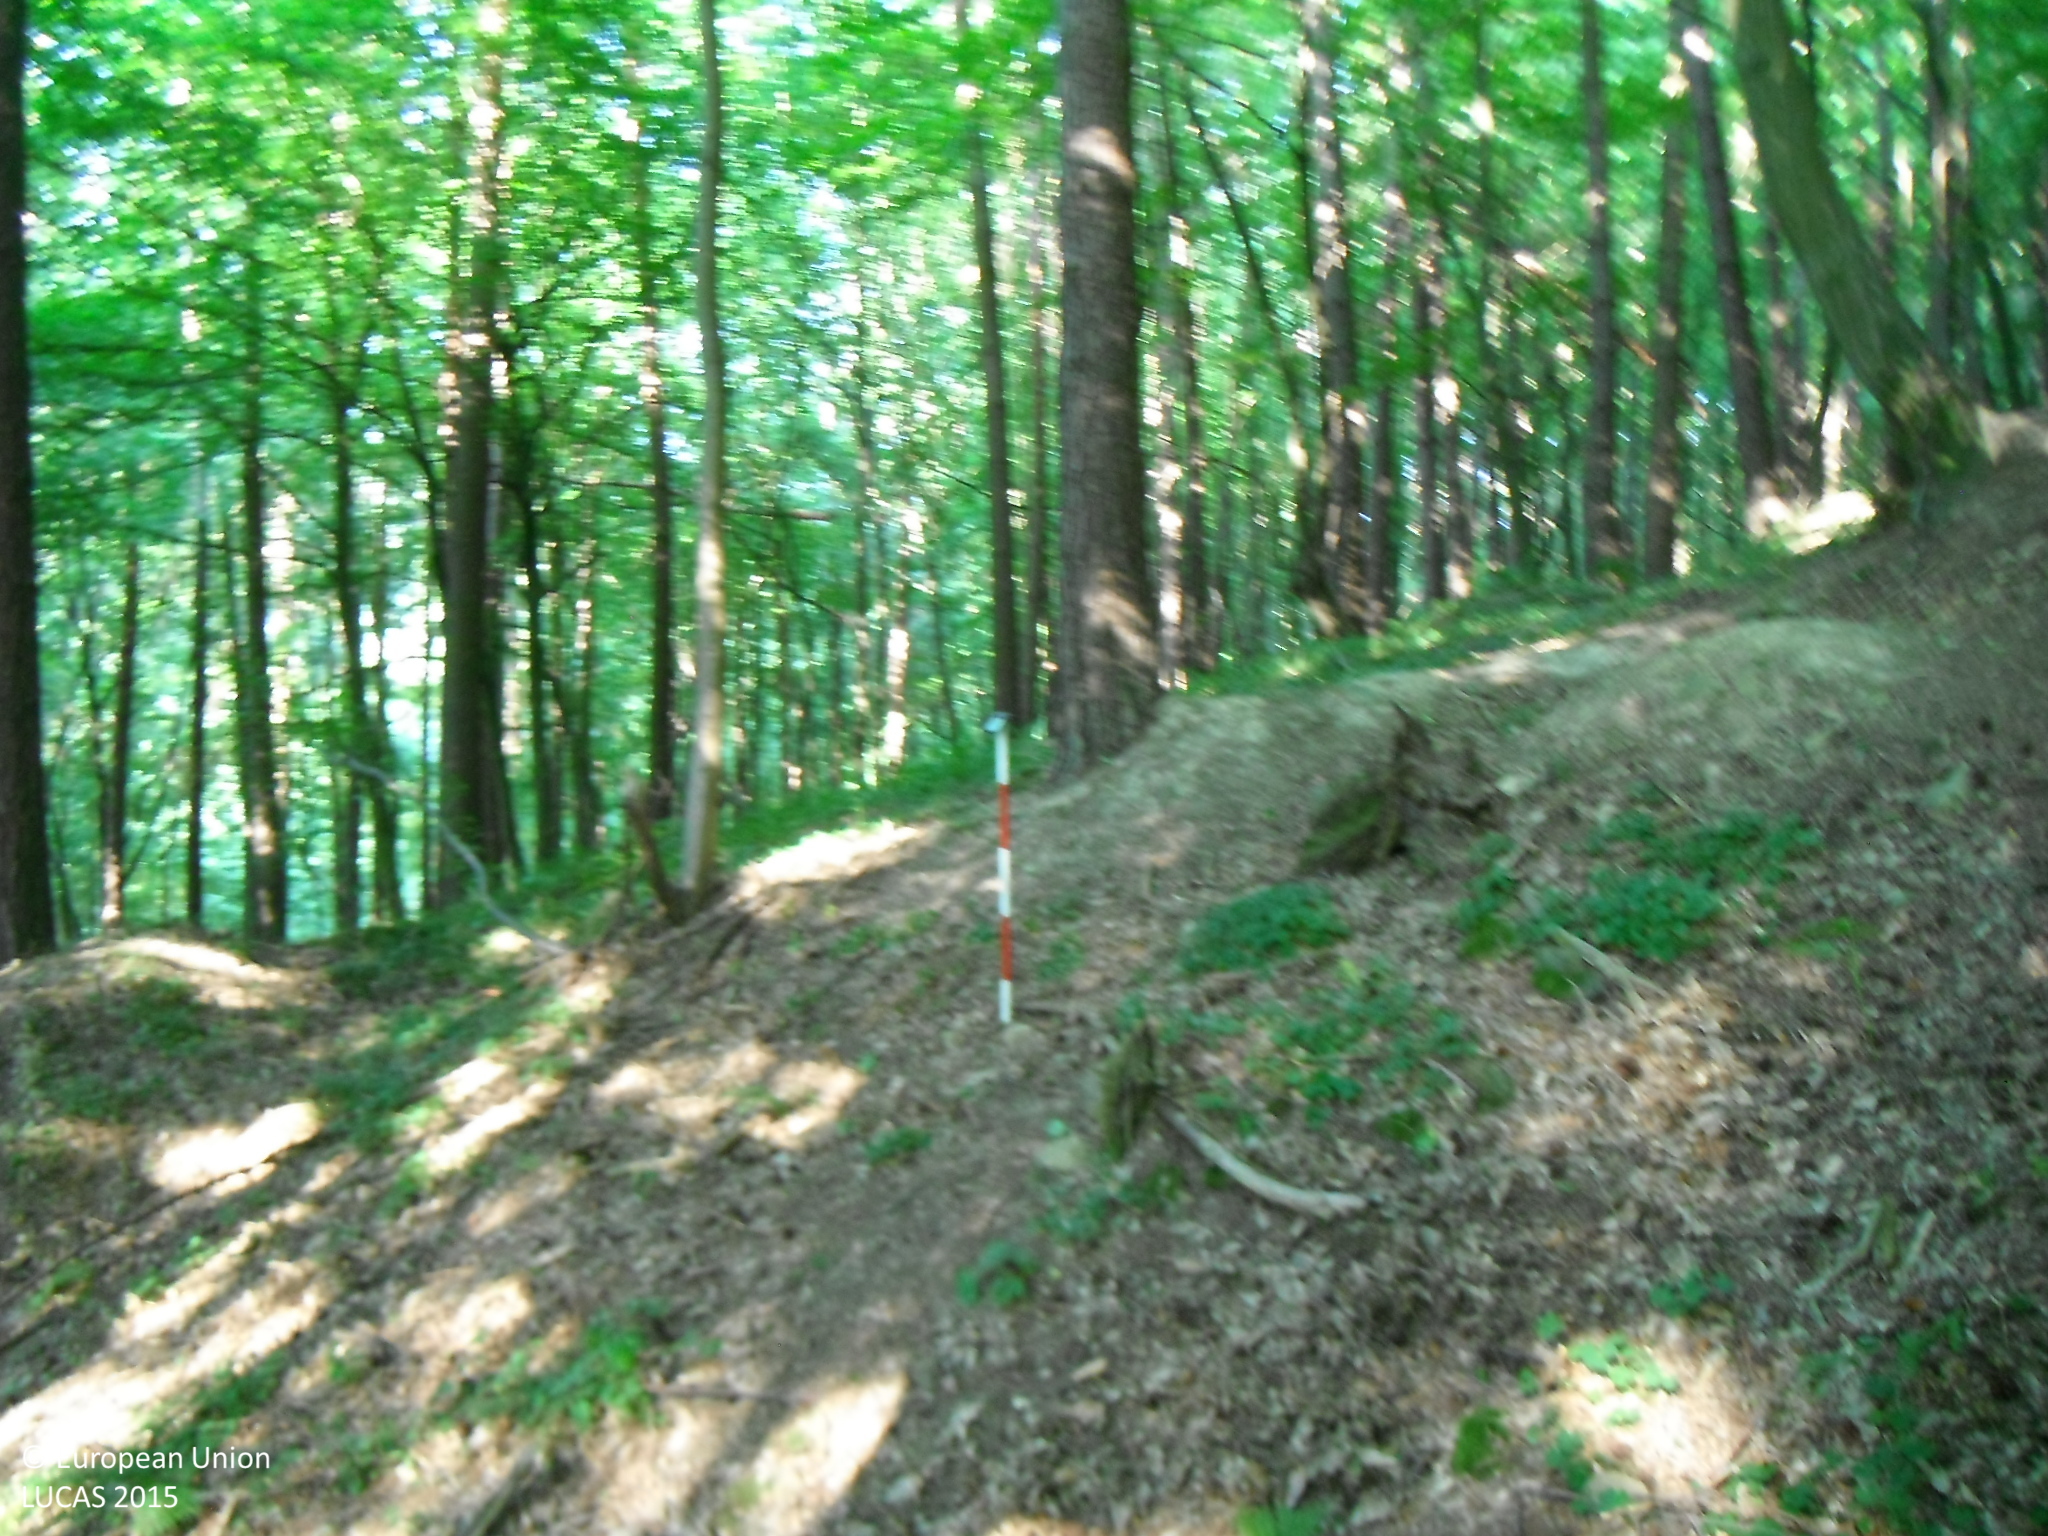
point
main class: Woodland
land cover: Pine dominated mixed woodland
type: hemiboreal forest and nemoral coniferous forest and mixed broadleaved-coniferous forest
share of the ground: > 75 %
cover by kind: coniferous forest trees 50 %, broadleaved forest trees 50 %
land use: Forestry
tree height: > 5 m
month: July
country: SK
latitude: 49.1091
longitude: 18.4699
